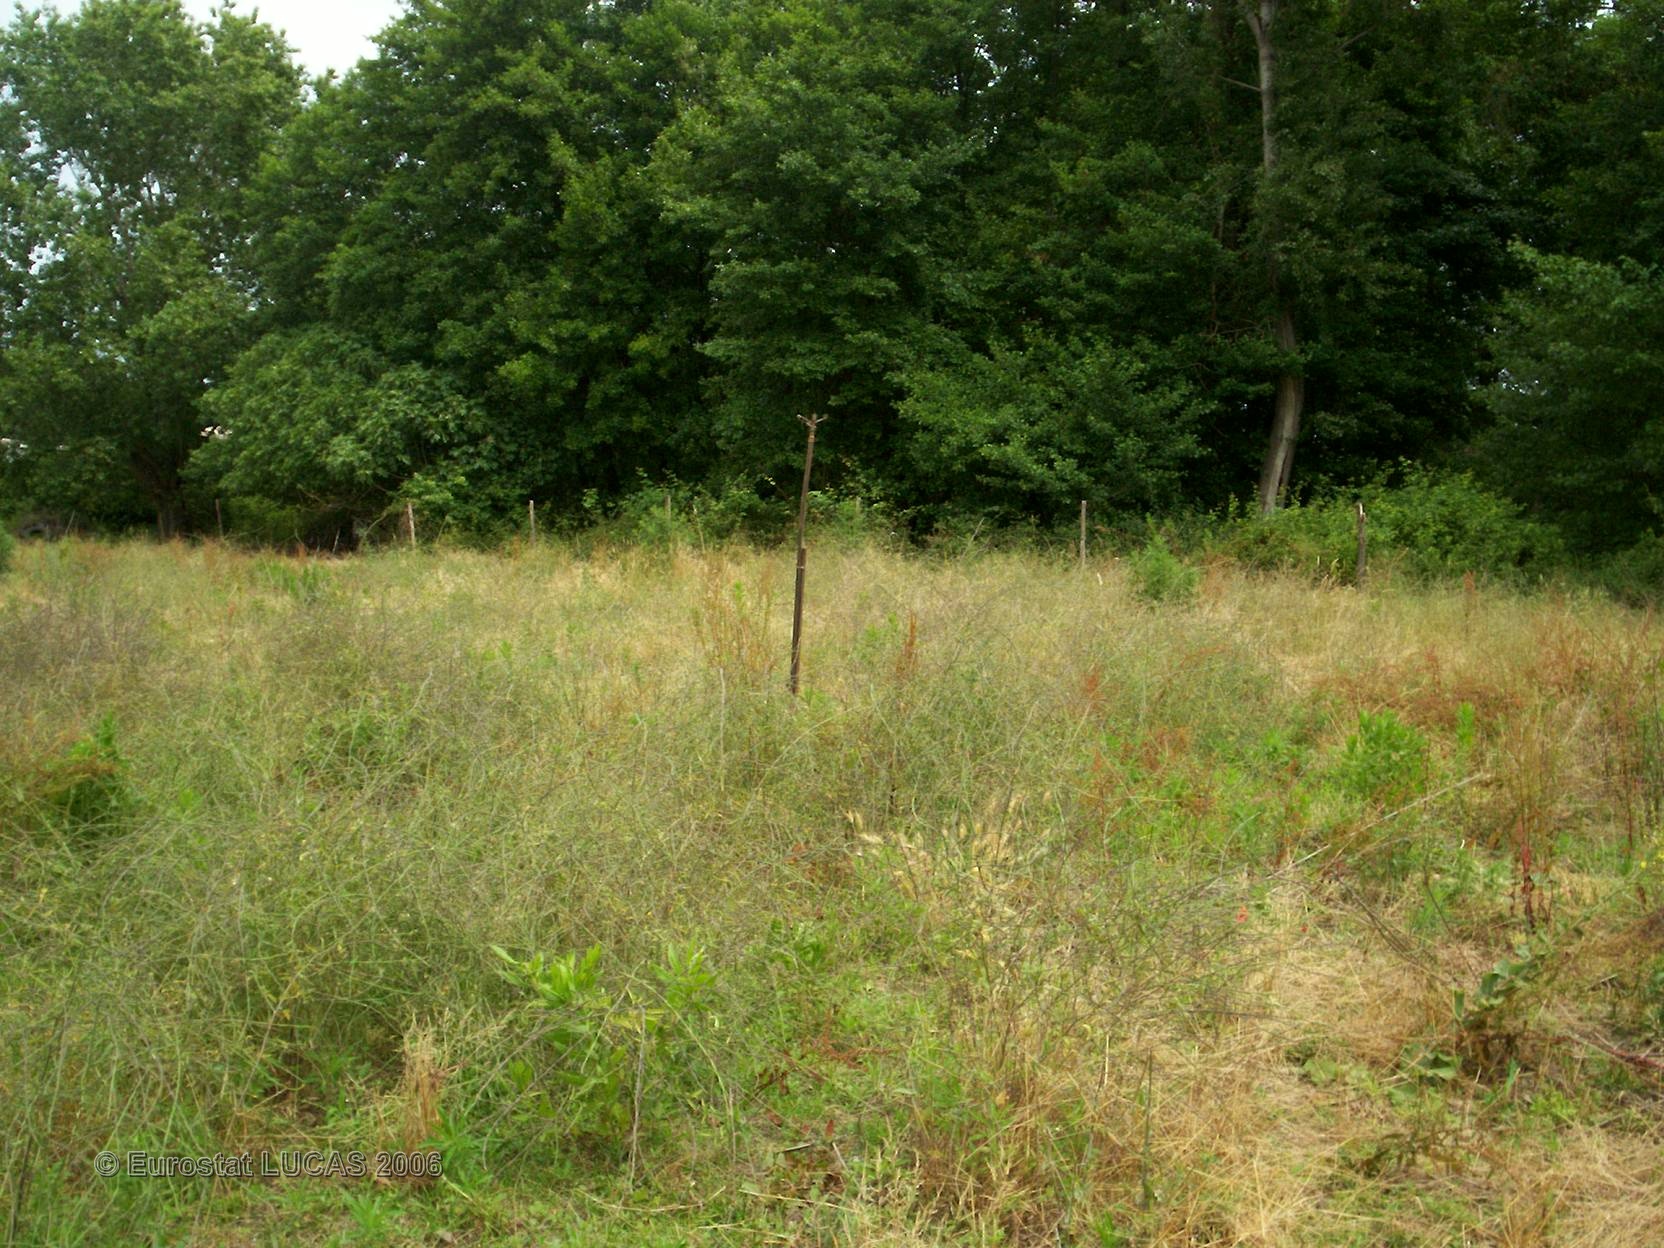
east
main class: Grassland
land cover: Grassland without tree/shrub cover
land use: Agriculture (excluding fallow land and kitchen gardens)
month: June
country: FR
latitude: 42.2916
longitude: 9.5287
